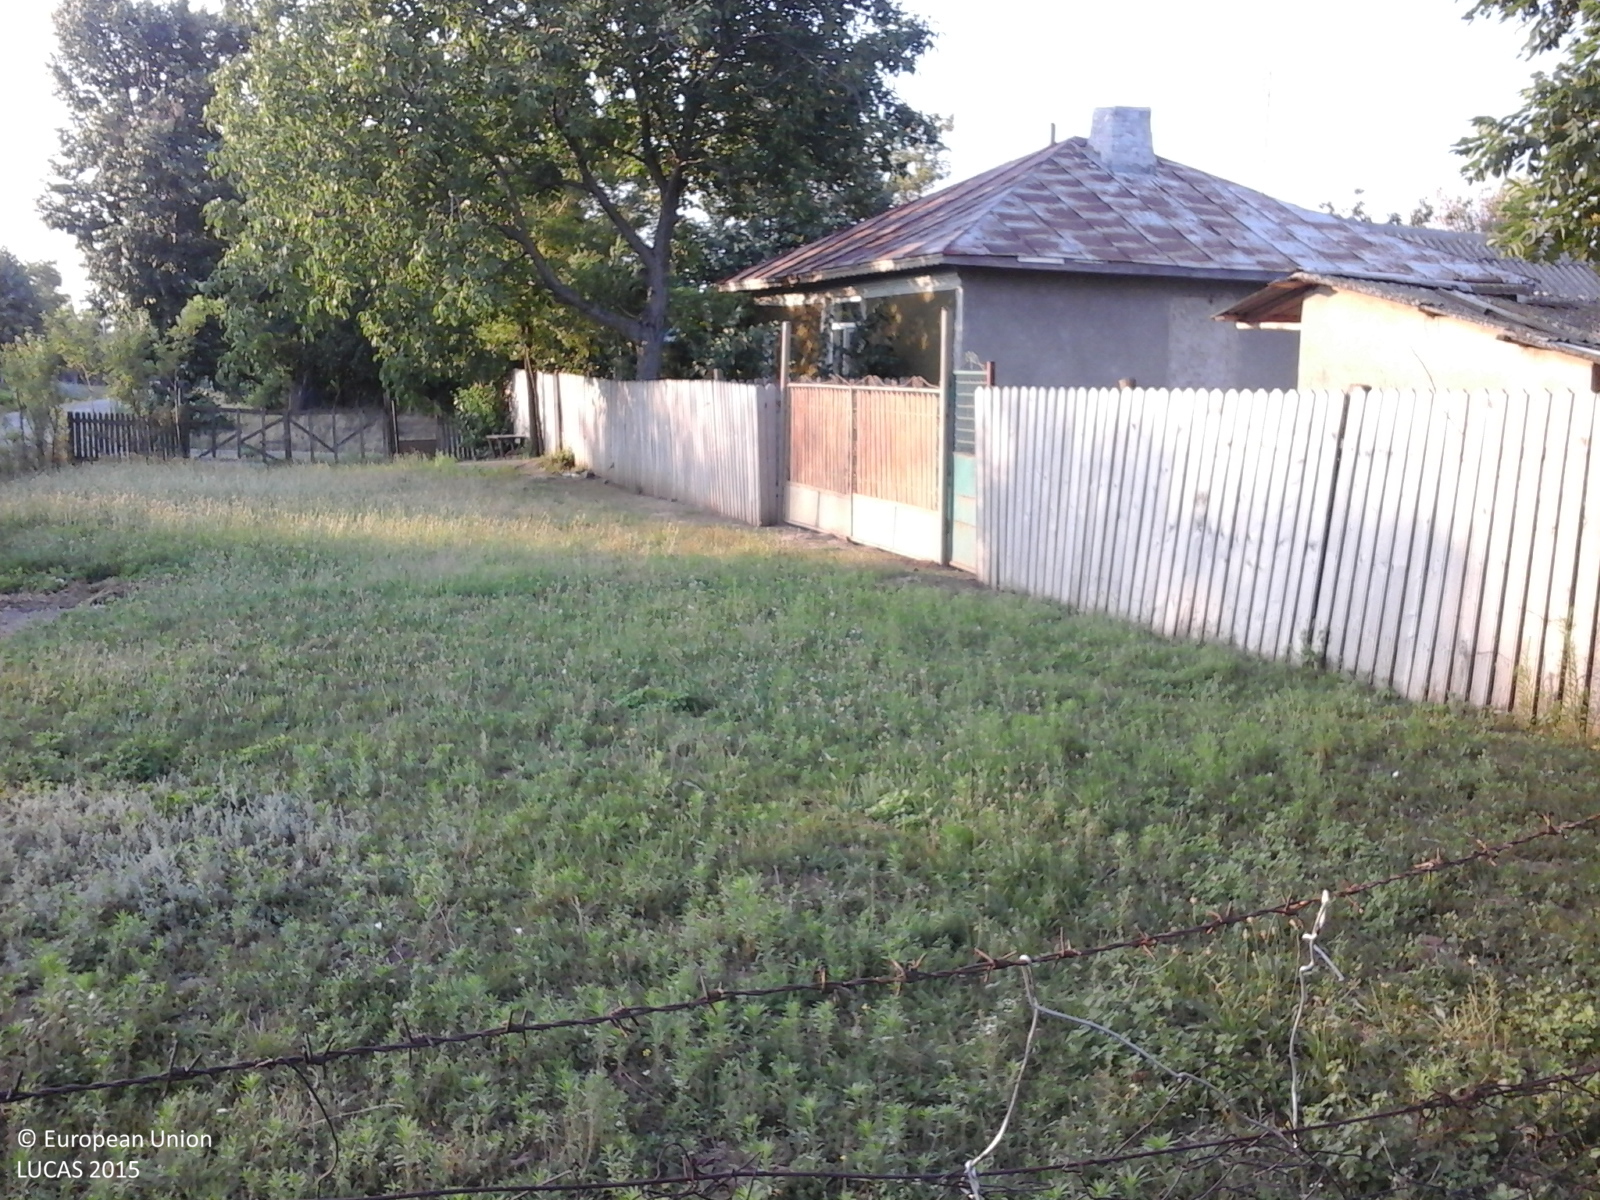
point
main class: Grassland
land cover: Grassland without tree/shrub cover
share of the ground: > 75 %
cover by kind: herbaceous plants 100 %
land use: Agriculture (excluding fallow land and kitchen gardens)
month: July
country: RO
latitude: 44.6011
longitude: 27.0515
